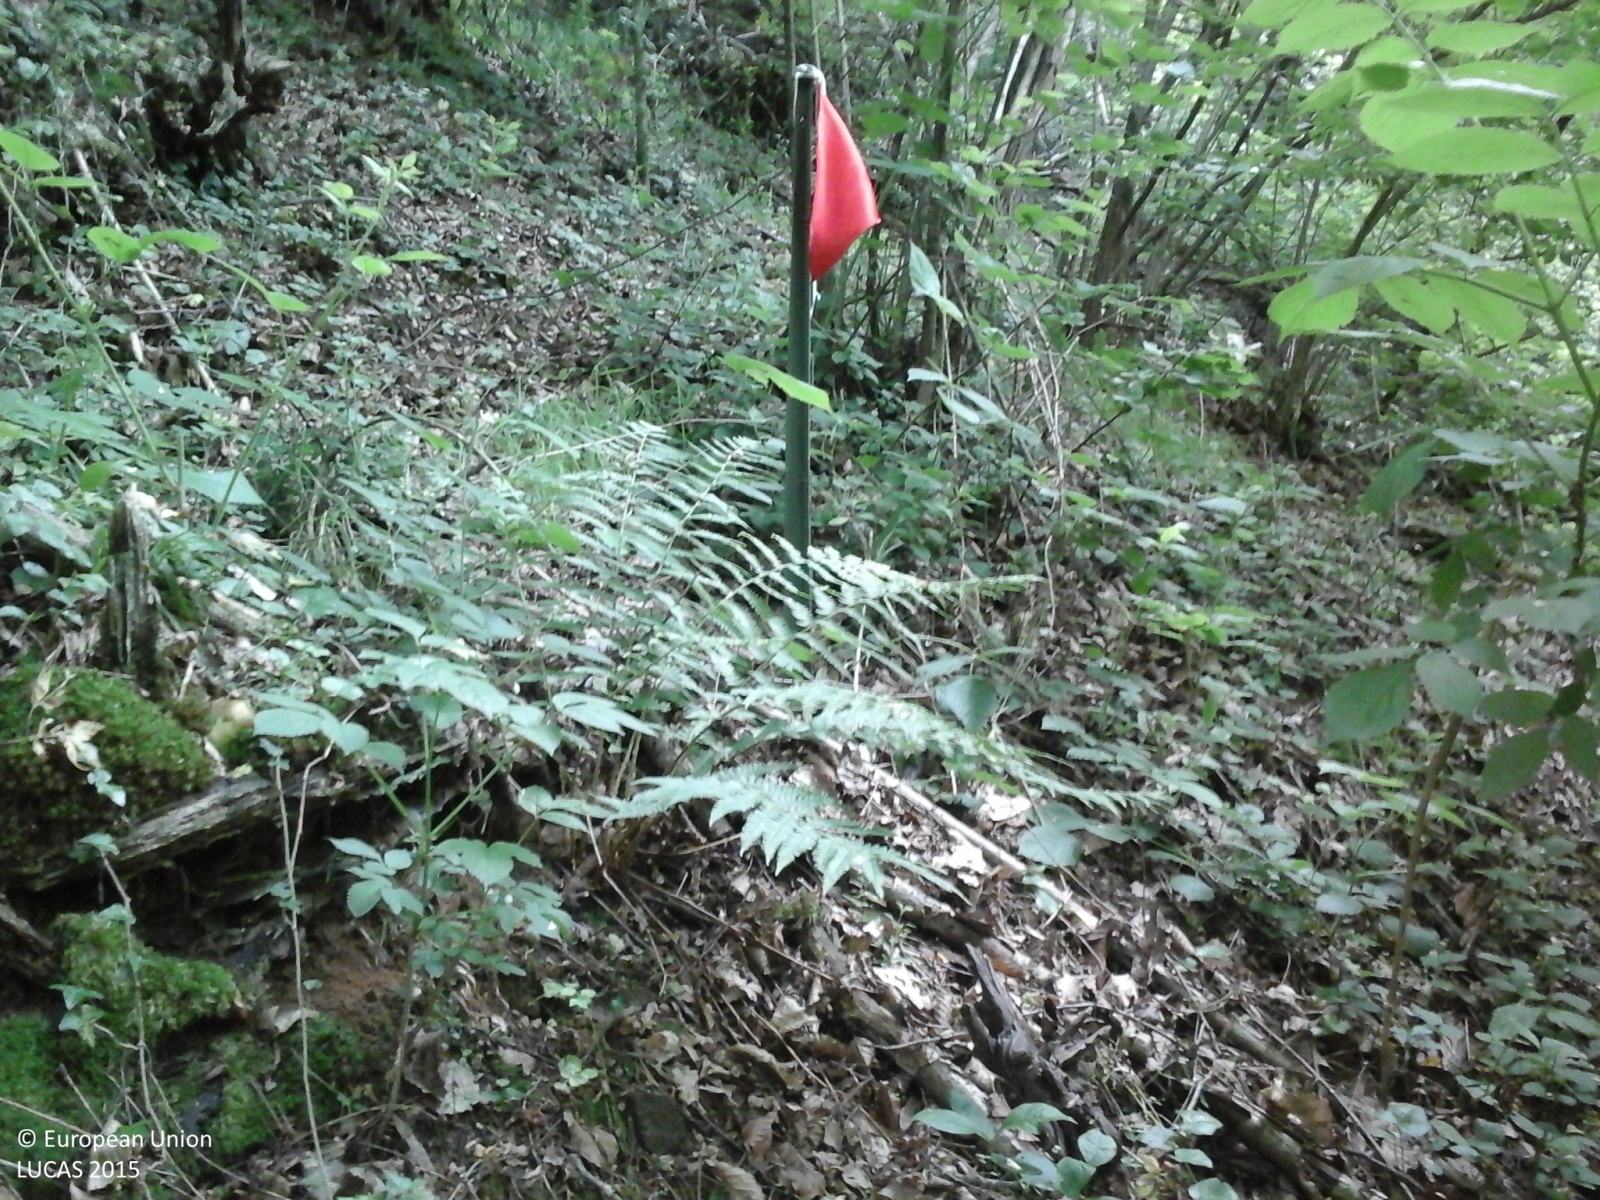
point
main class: Woodland
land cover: Broadleaved woodland
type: mesophytic deciduous forest
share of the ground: > 75 %
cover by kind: broadleaved forest trees 100 %
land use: Forestry
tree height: > 5 m
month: May
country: IT
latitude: 45.5615
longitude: 8.2220
